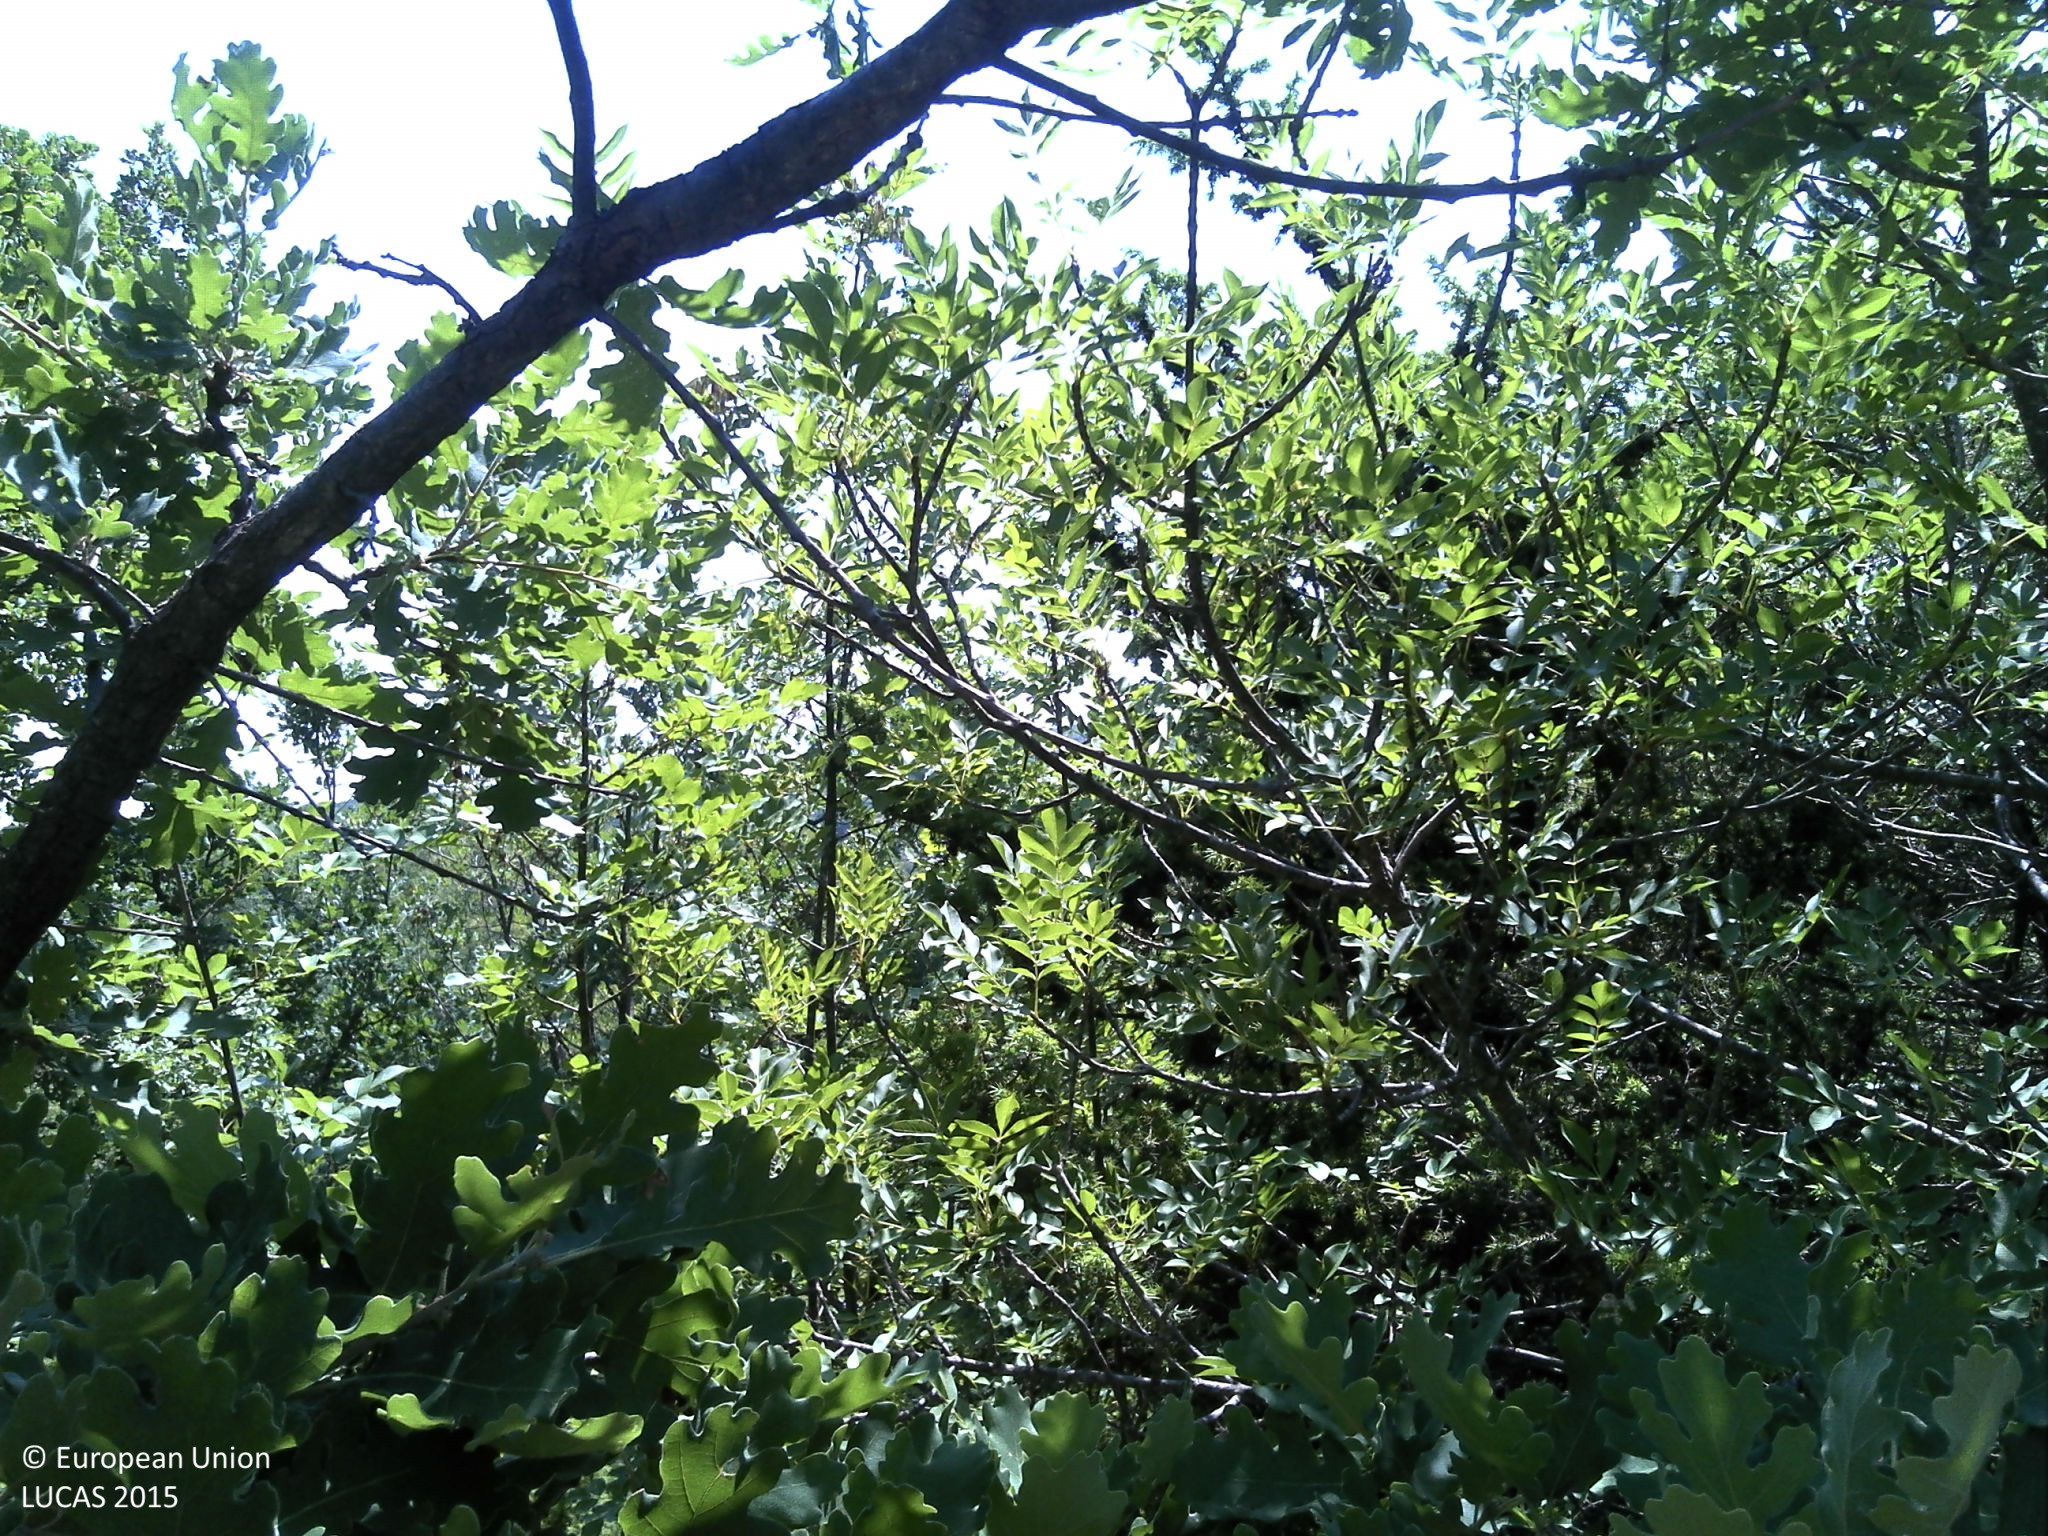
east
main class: Woodland
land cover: Broadleaved woodland
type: thermophilous deciduous forest
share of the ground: 50 - 75 %
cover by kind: broadleaved forest trees 60 %, shrubs 25 %, unconsolidated bare surface 10 %, consolidated bare surface 5 %
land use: Semi-natural and natural areas not in use
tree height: > 5 m
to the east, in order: Broadleaved woodland; Shrubland with sparse tree cover; Broadleaved woodland; Tracks; Broadleaved woodland; Dry stone walls; Broadleaved woodland; Grassland with sparse tree/shrub cover; Shrubland with sparse tree cover; Broadleaved woodland
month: June
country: HR
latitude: 43.6015
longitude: 16.2470
